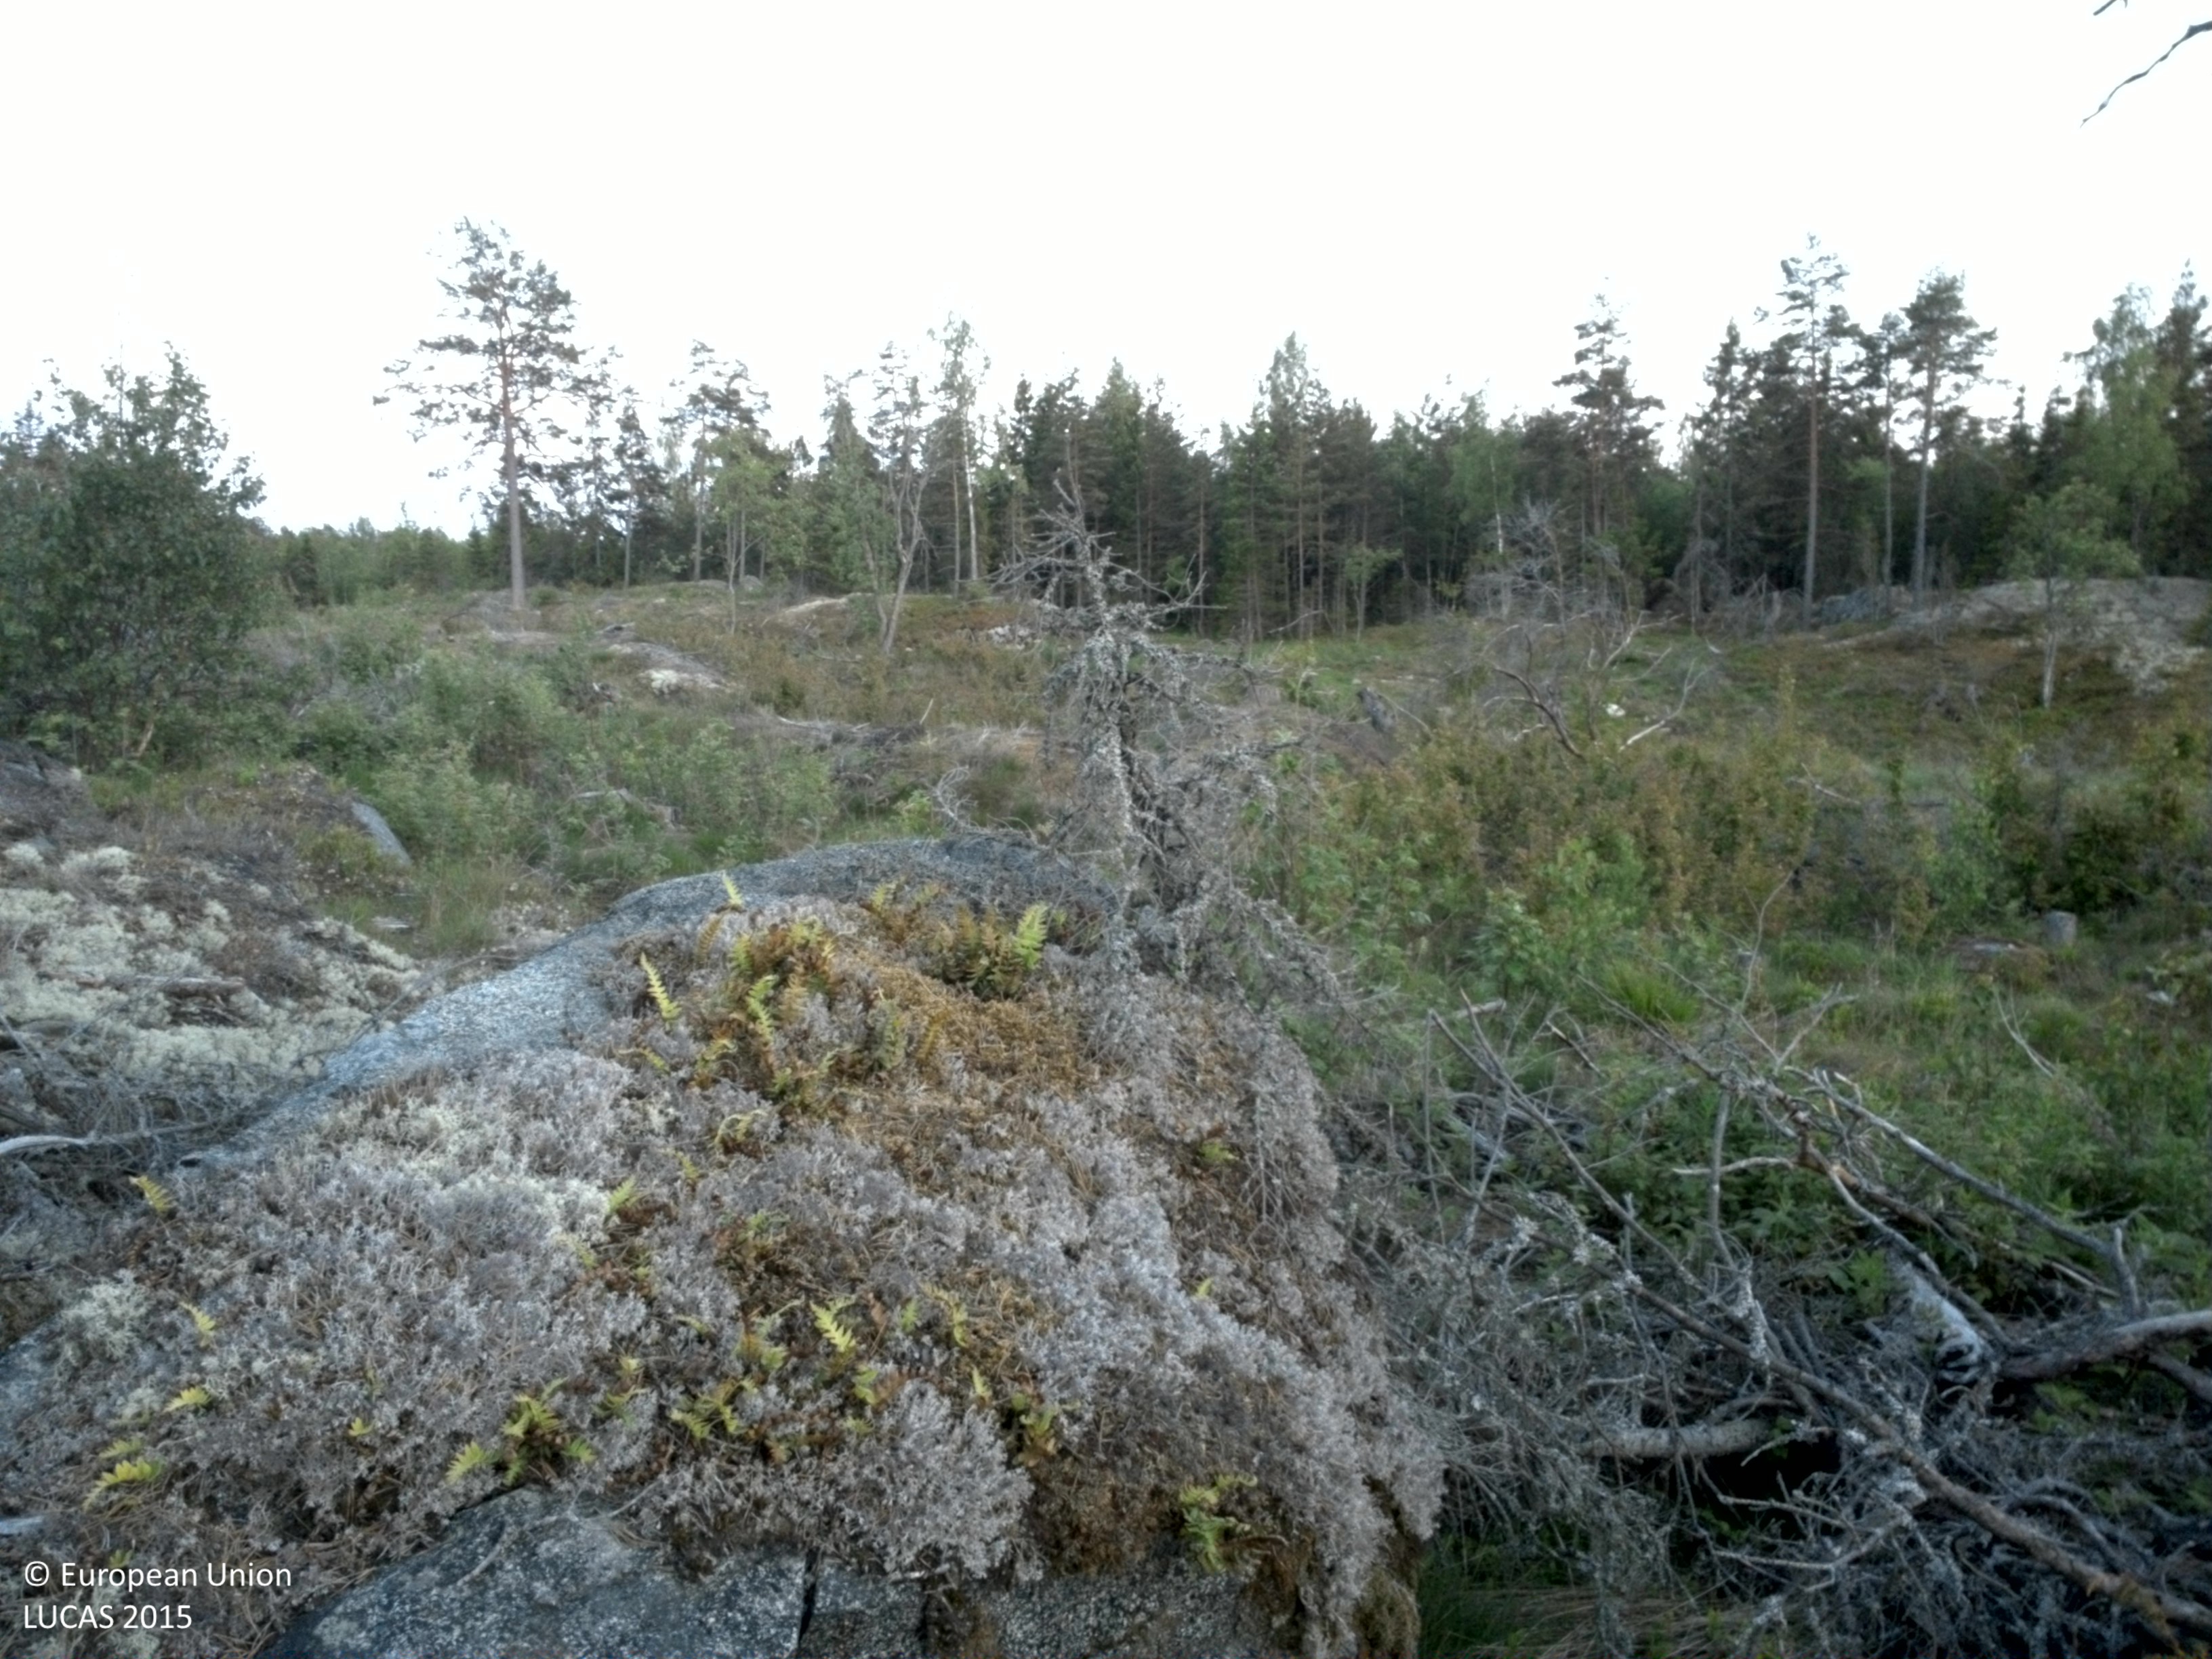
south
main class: Shrubland
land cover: Shrubland with sparse tree cover
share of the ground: 25 - 50 %
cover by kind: shrubs 35 %, consolidated bare surface 30 %, herbaceous plants 20 %, lichens and mosses 10 %, coniferous forest trees 5 %
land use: Forestry
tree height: > 5 m
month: June
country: SE
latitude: 60.0516
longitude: 18.7805
